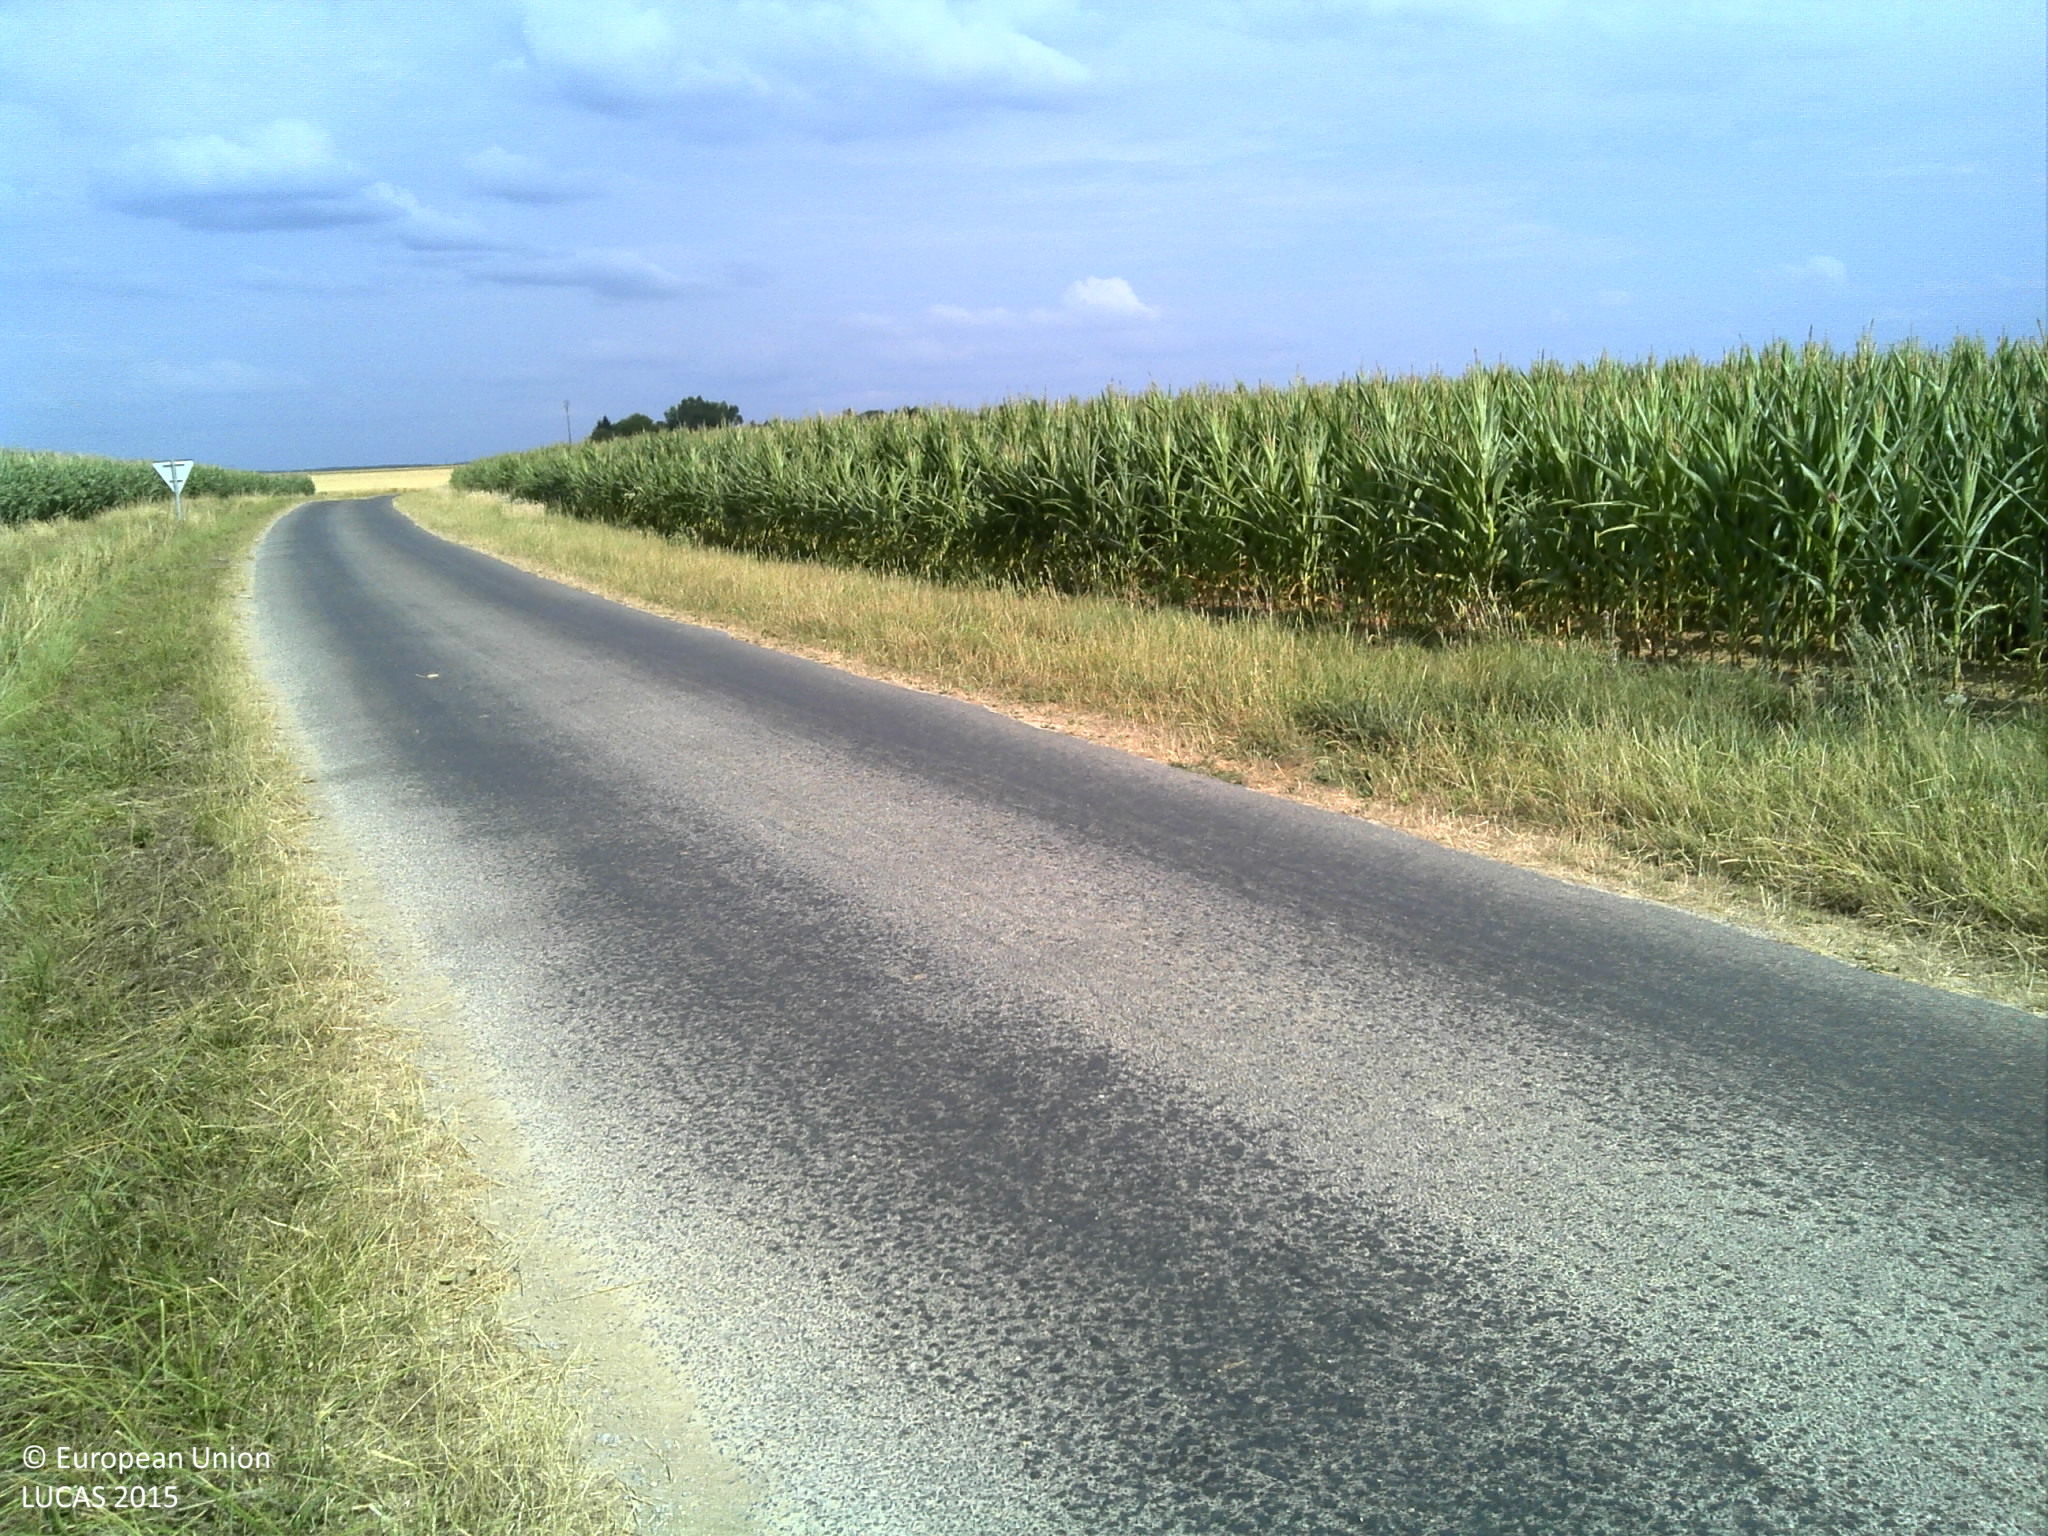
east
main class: Cropland
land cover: Rape and turnip rape
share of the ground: > 75 %
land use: Agriculture (excluding fallow land and kitchen gardens)
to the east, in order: Ditches and canals; Grass margins; Tracks; Grass margins; Ditches and canals; Grass margins; Rape and turnip rape
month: July
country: FR
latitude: 49.0415
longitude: 4.8675
